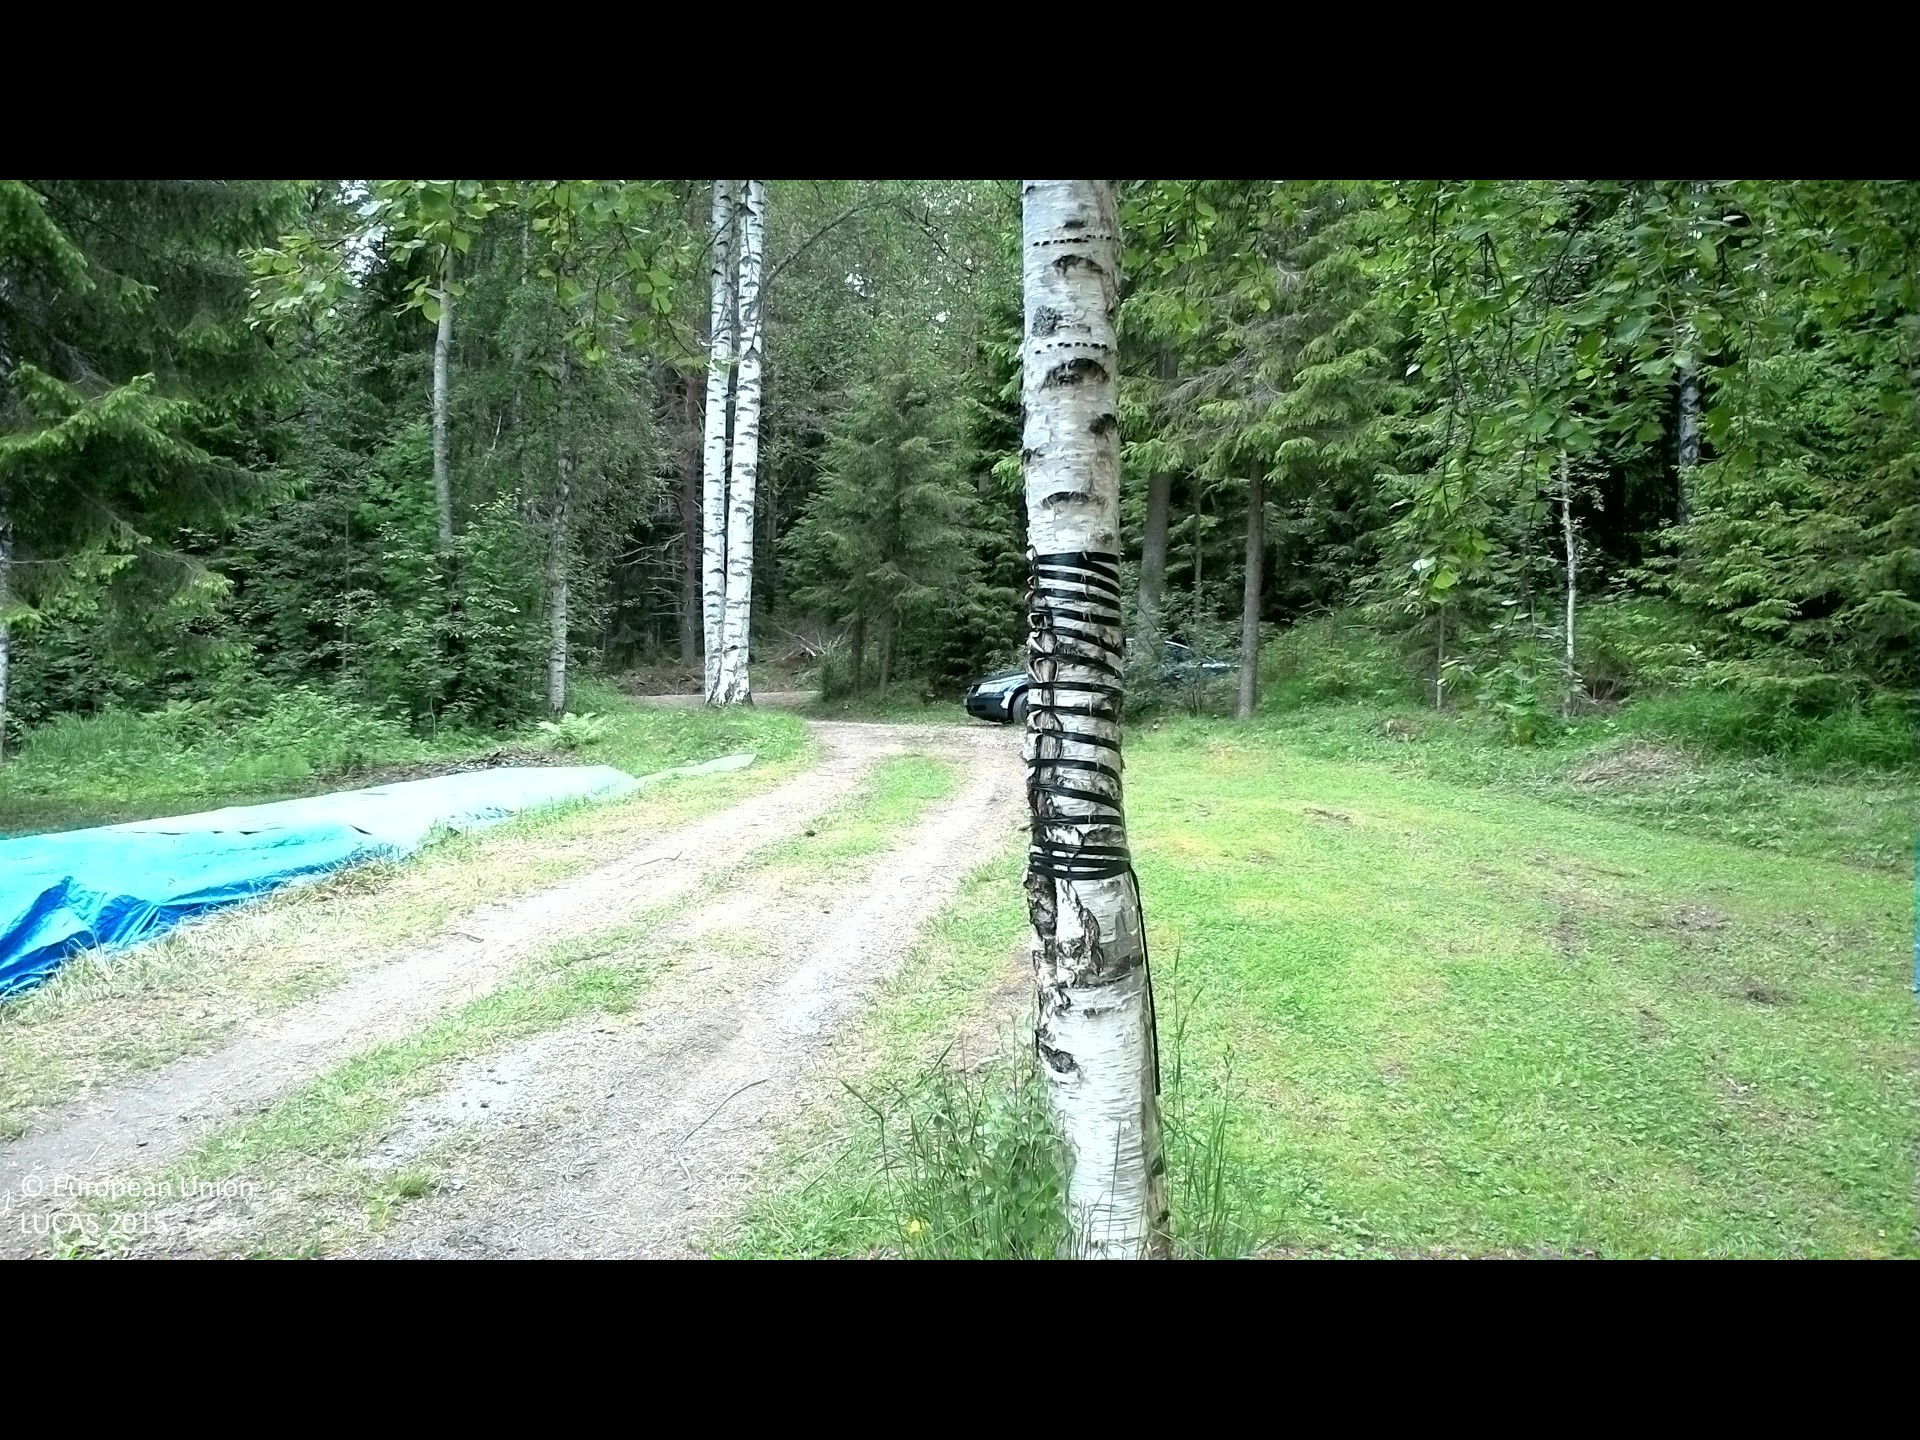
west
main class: Grassland
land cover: Grassland without tree/shrub cover
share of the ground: > 75 %
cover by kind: herbaceous plants 100 %
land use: Residential
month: June
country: SE
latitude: 62.0426
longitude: 16.3868
